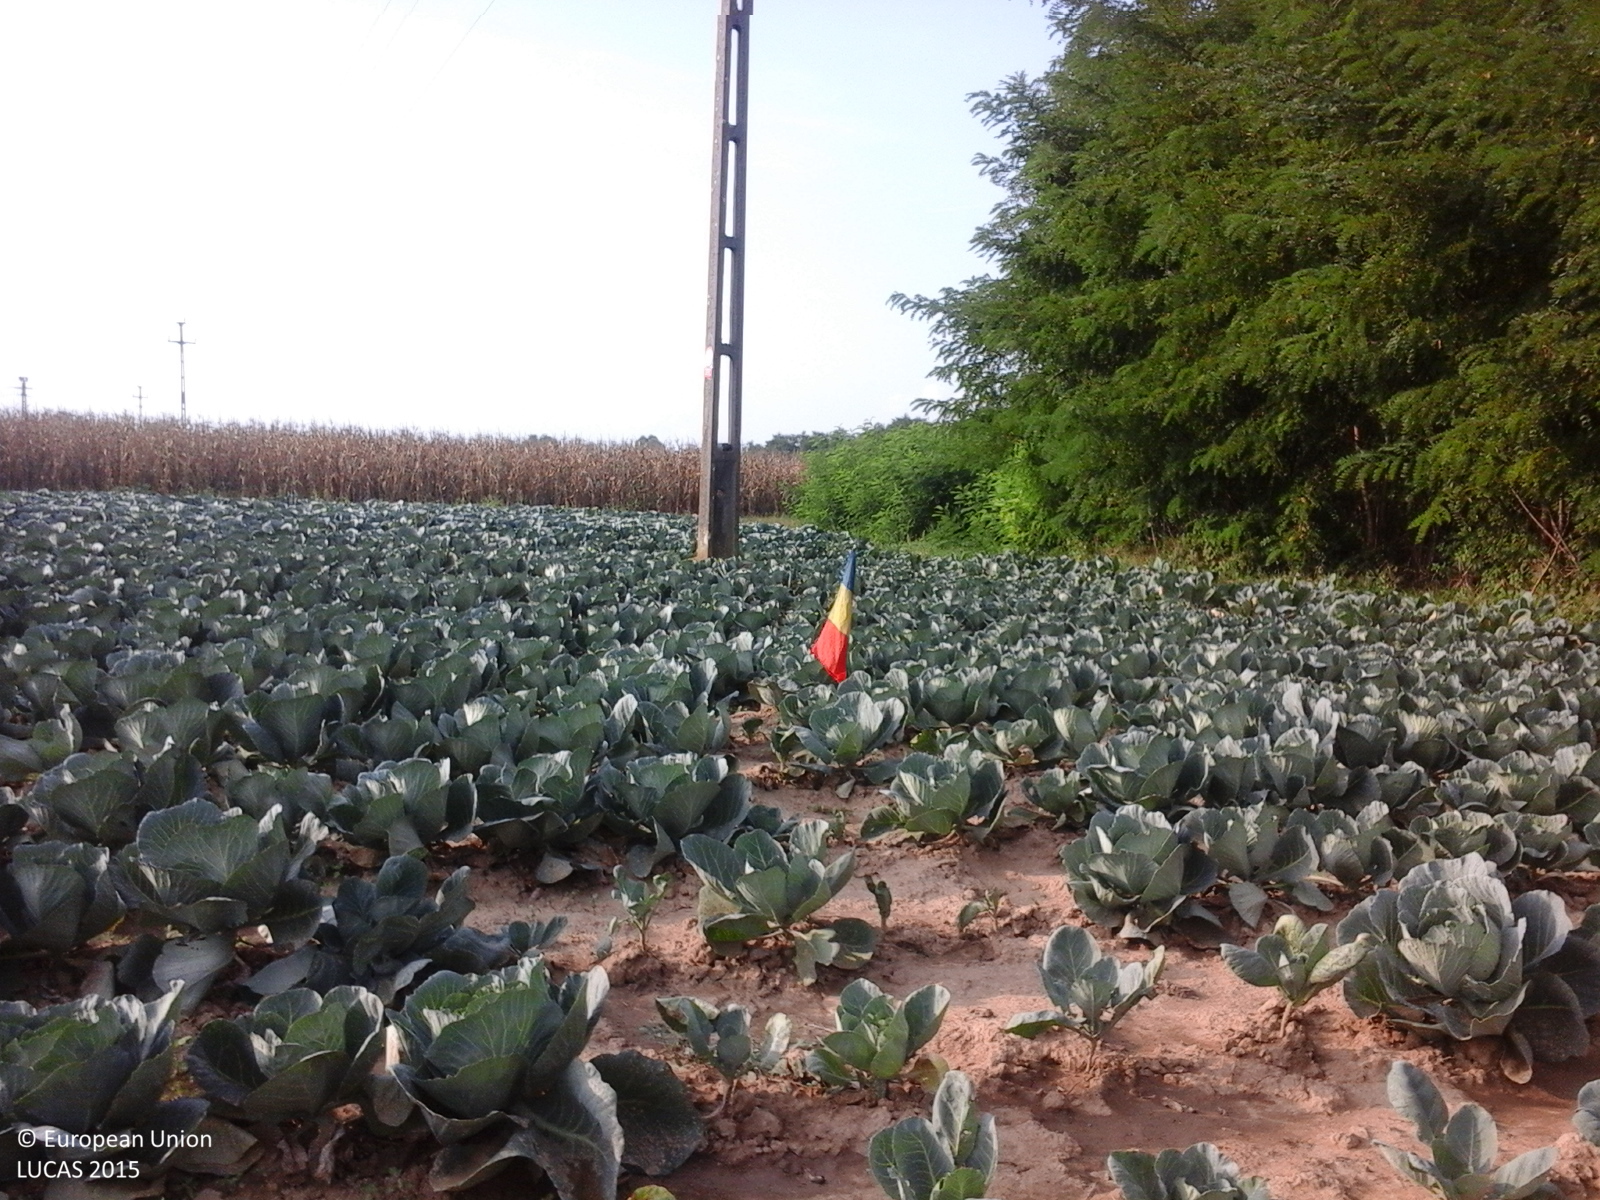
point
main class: Cropland
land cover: Other fresh vegetables
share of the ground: > 75 %
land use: Agriculture (excluding fallow land and kitchen gardens)
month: September
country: RO
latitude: 45.7924
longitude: 22.0694
